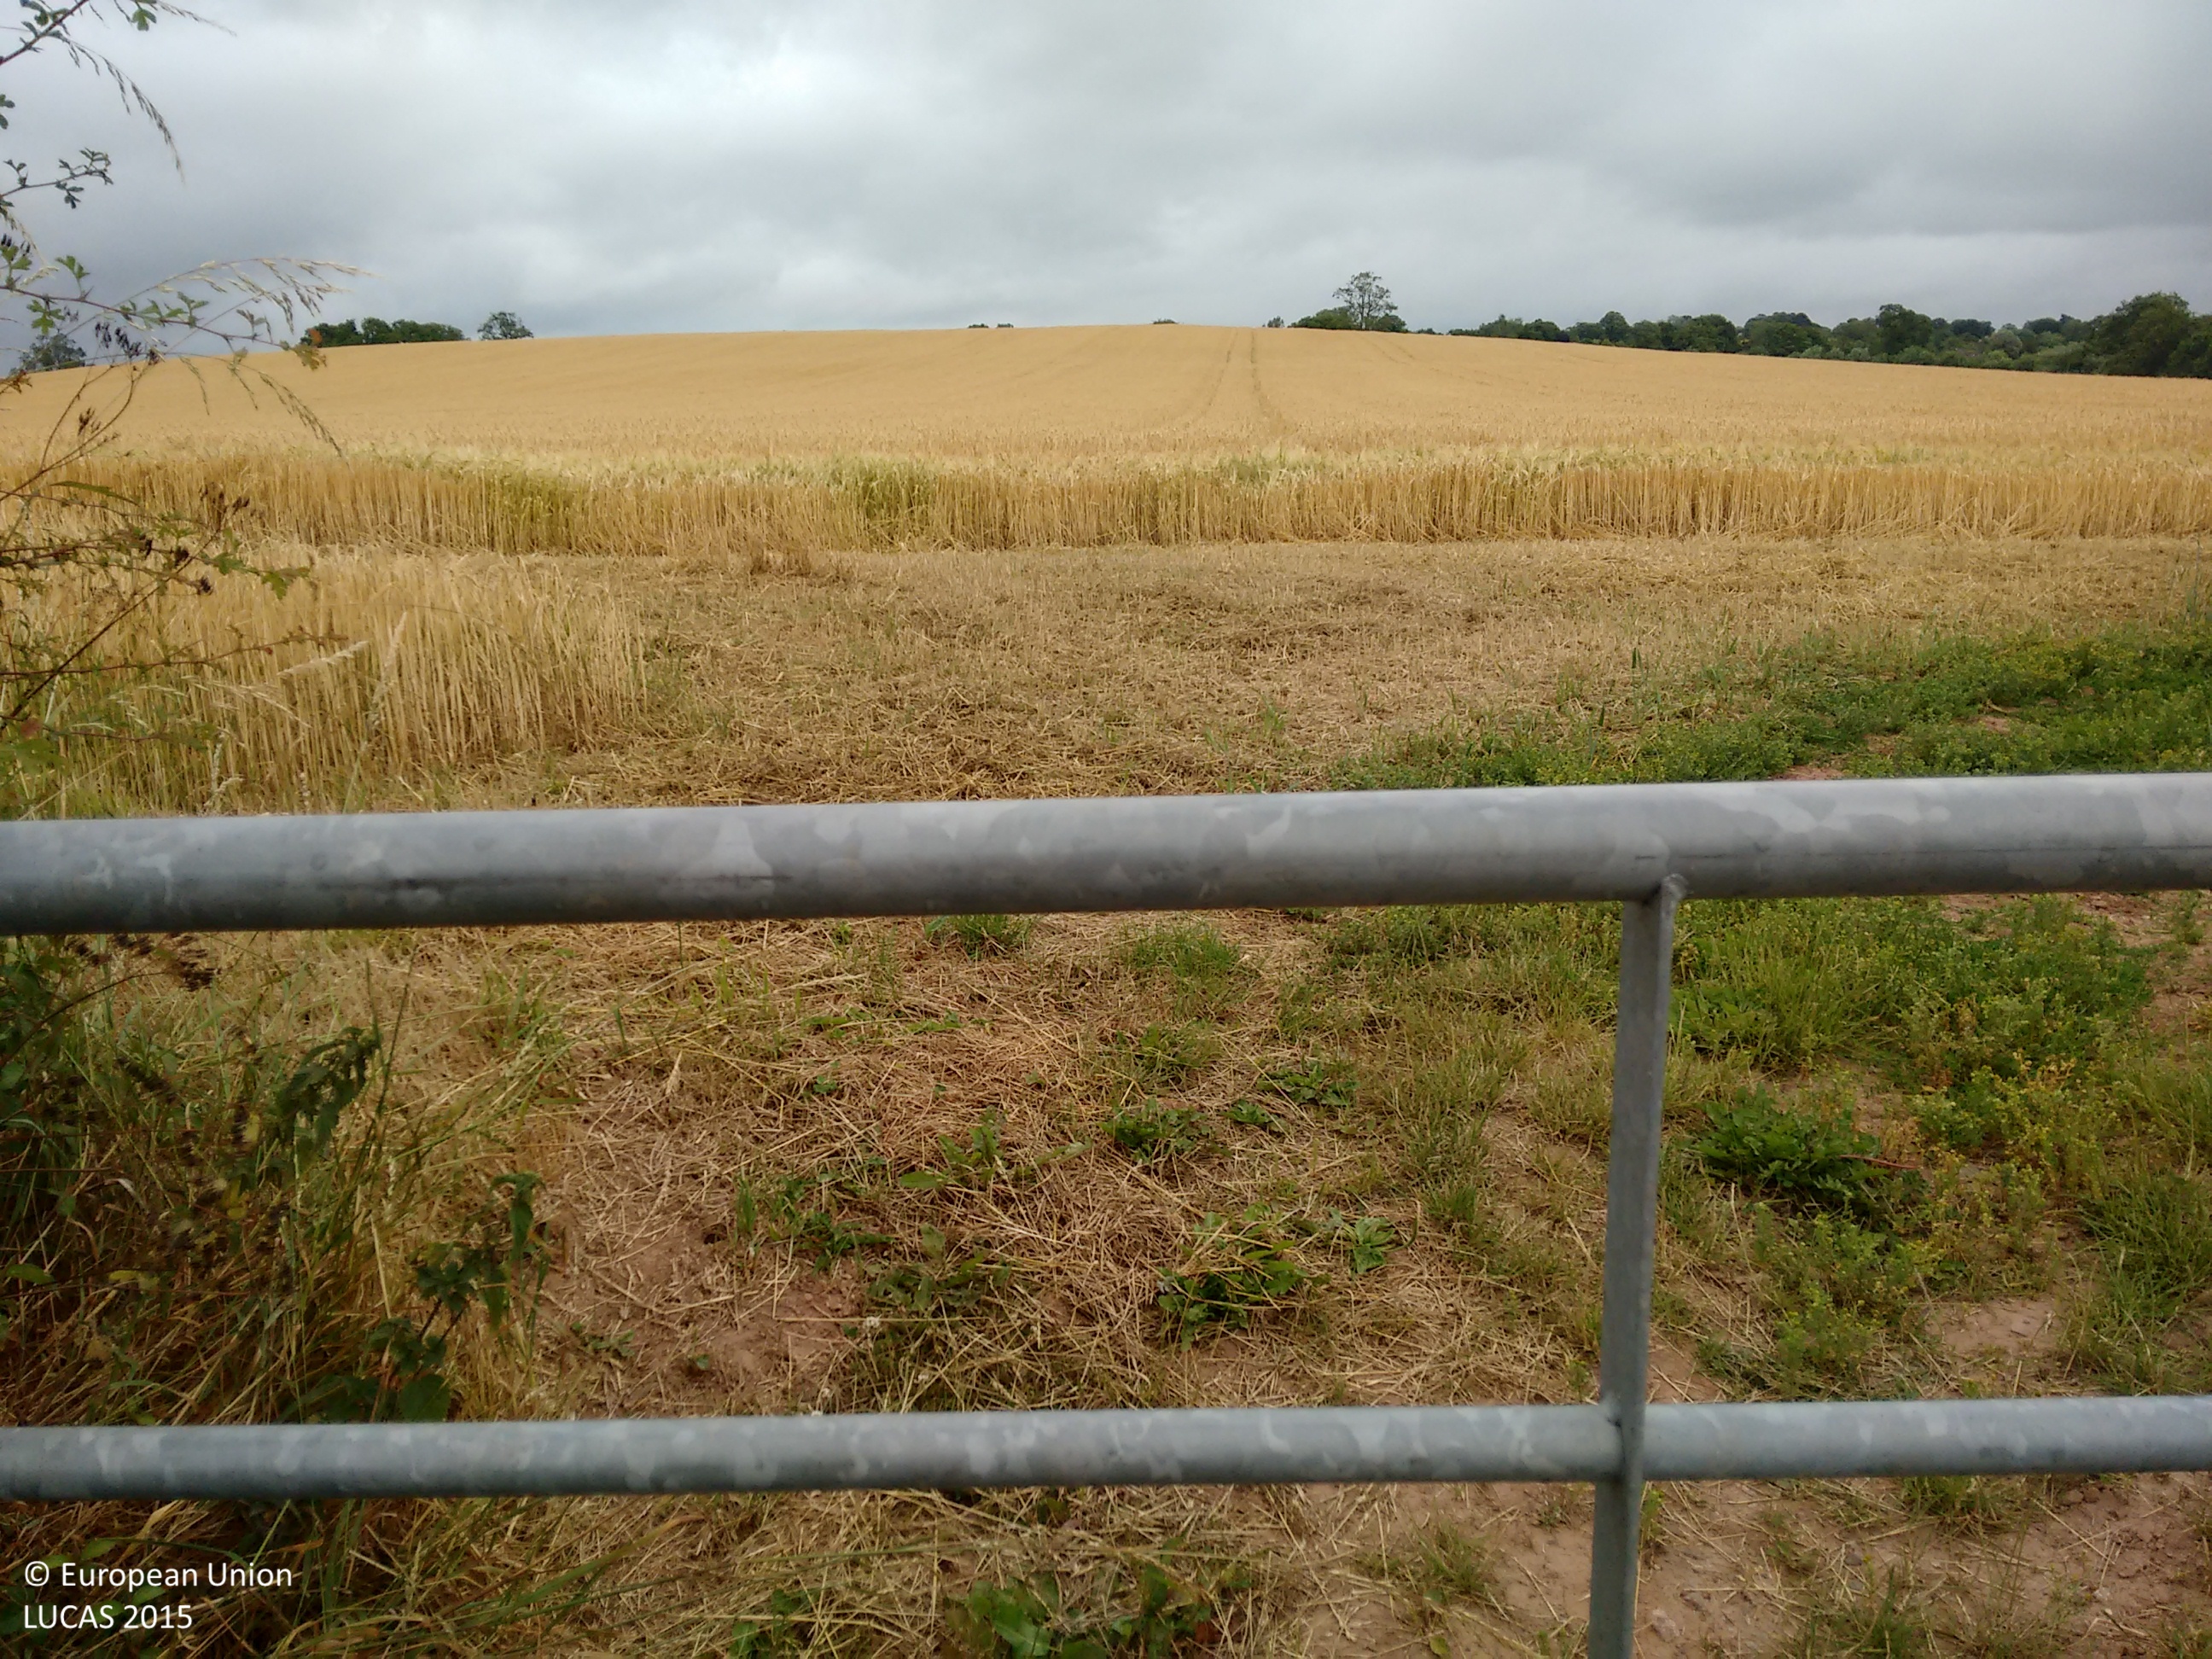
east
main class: Cropland
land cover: Barley
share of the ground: > 75 %
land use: Agriculture (excluding fallow land and kitchen gardens)
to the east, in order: Barley; Grassland without tree/shrub cover; Broadleaved woodland; Grassland without tree/shrub cover
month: July
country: GB
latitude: 52.2373
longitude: -2.7073
